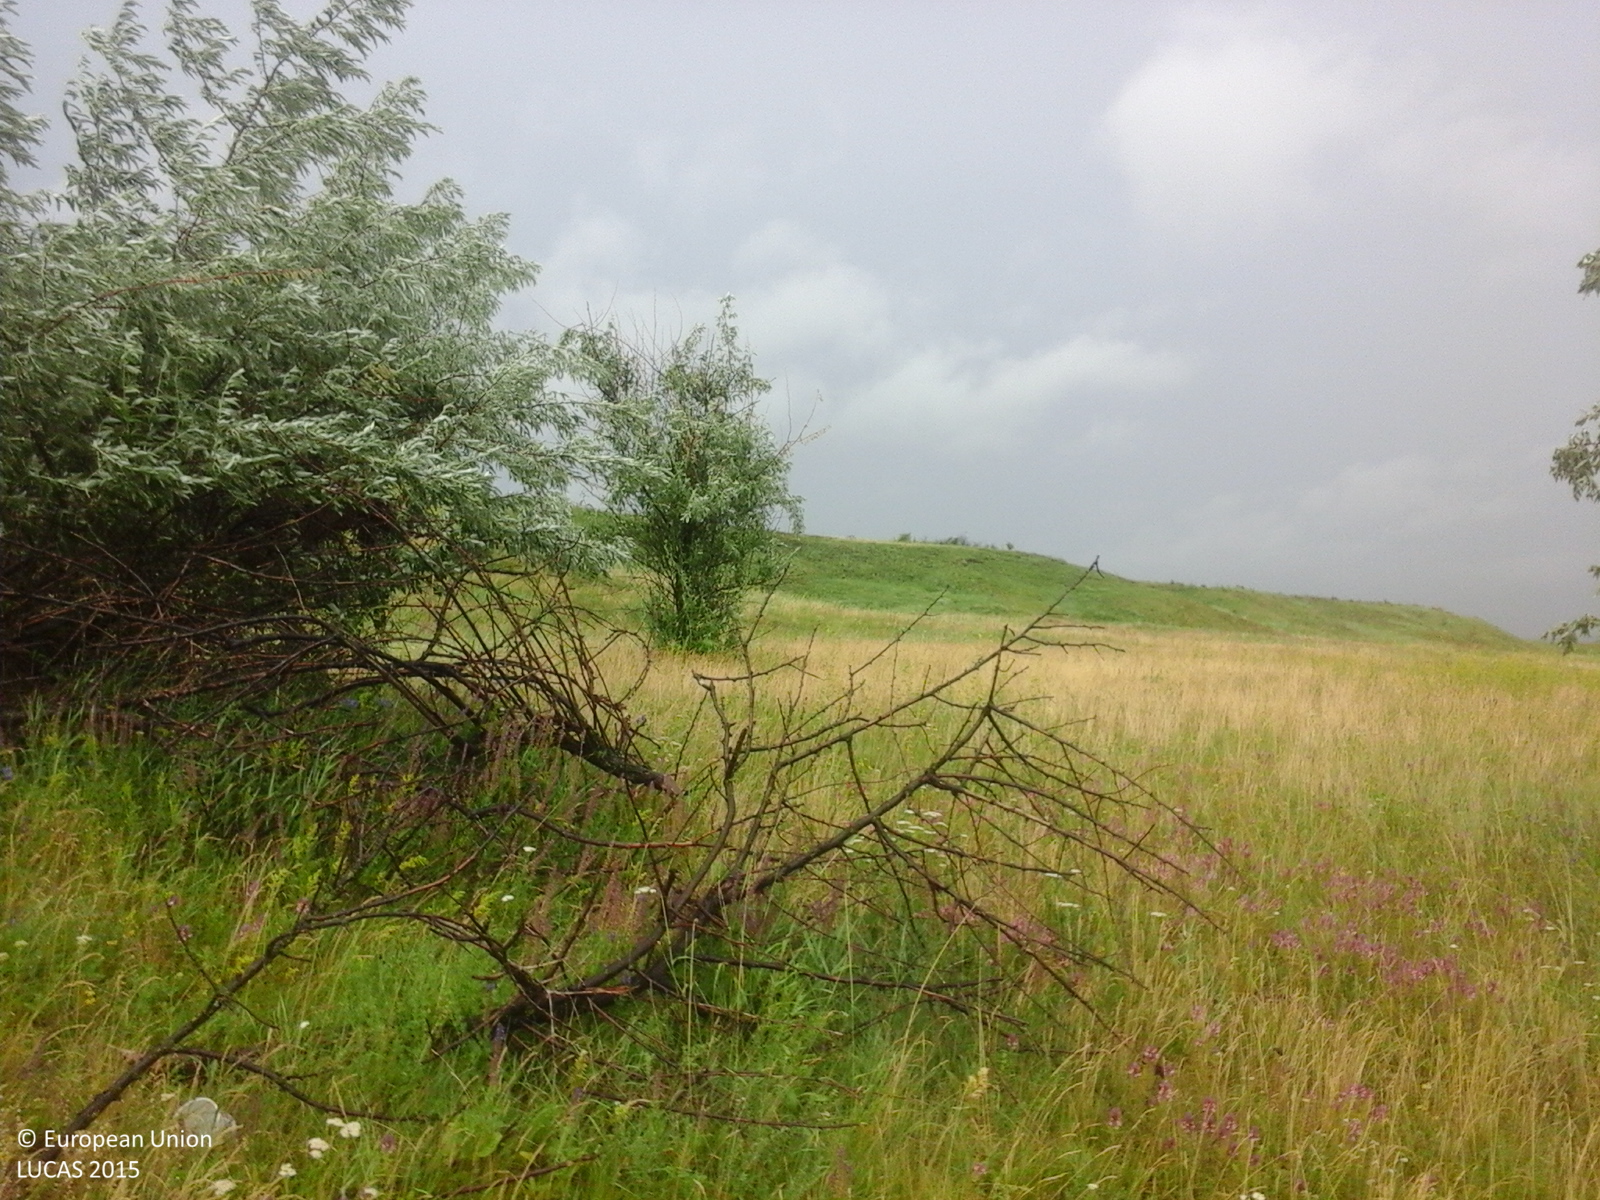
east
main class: Grassland
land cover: Grassland with sparse tree/shrub cover
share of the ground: > 75 %
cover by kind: herbaceous plants 90 %, broadleaved forest trees 5 %, shrubs 5 %
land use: Agriculture (excluding fallow land and kitchen gardens)
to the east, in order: Grassland with sparse tree/shrub cover; Grassland without tree/shrub cover; Lucerne; Maize
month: June
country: RO
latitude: 47.9273
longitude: 26.5966
